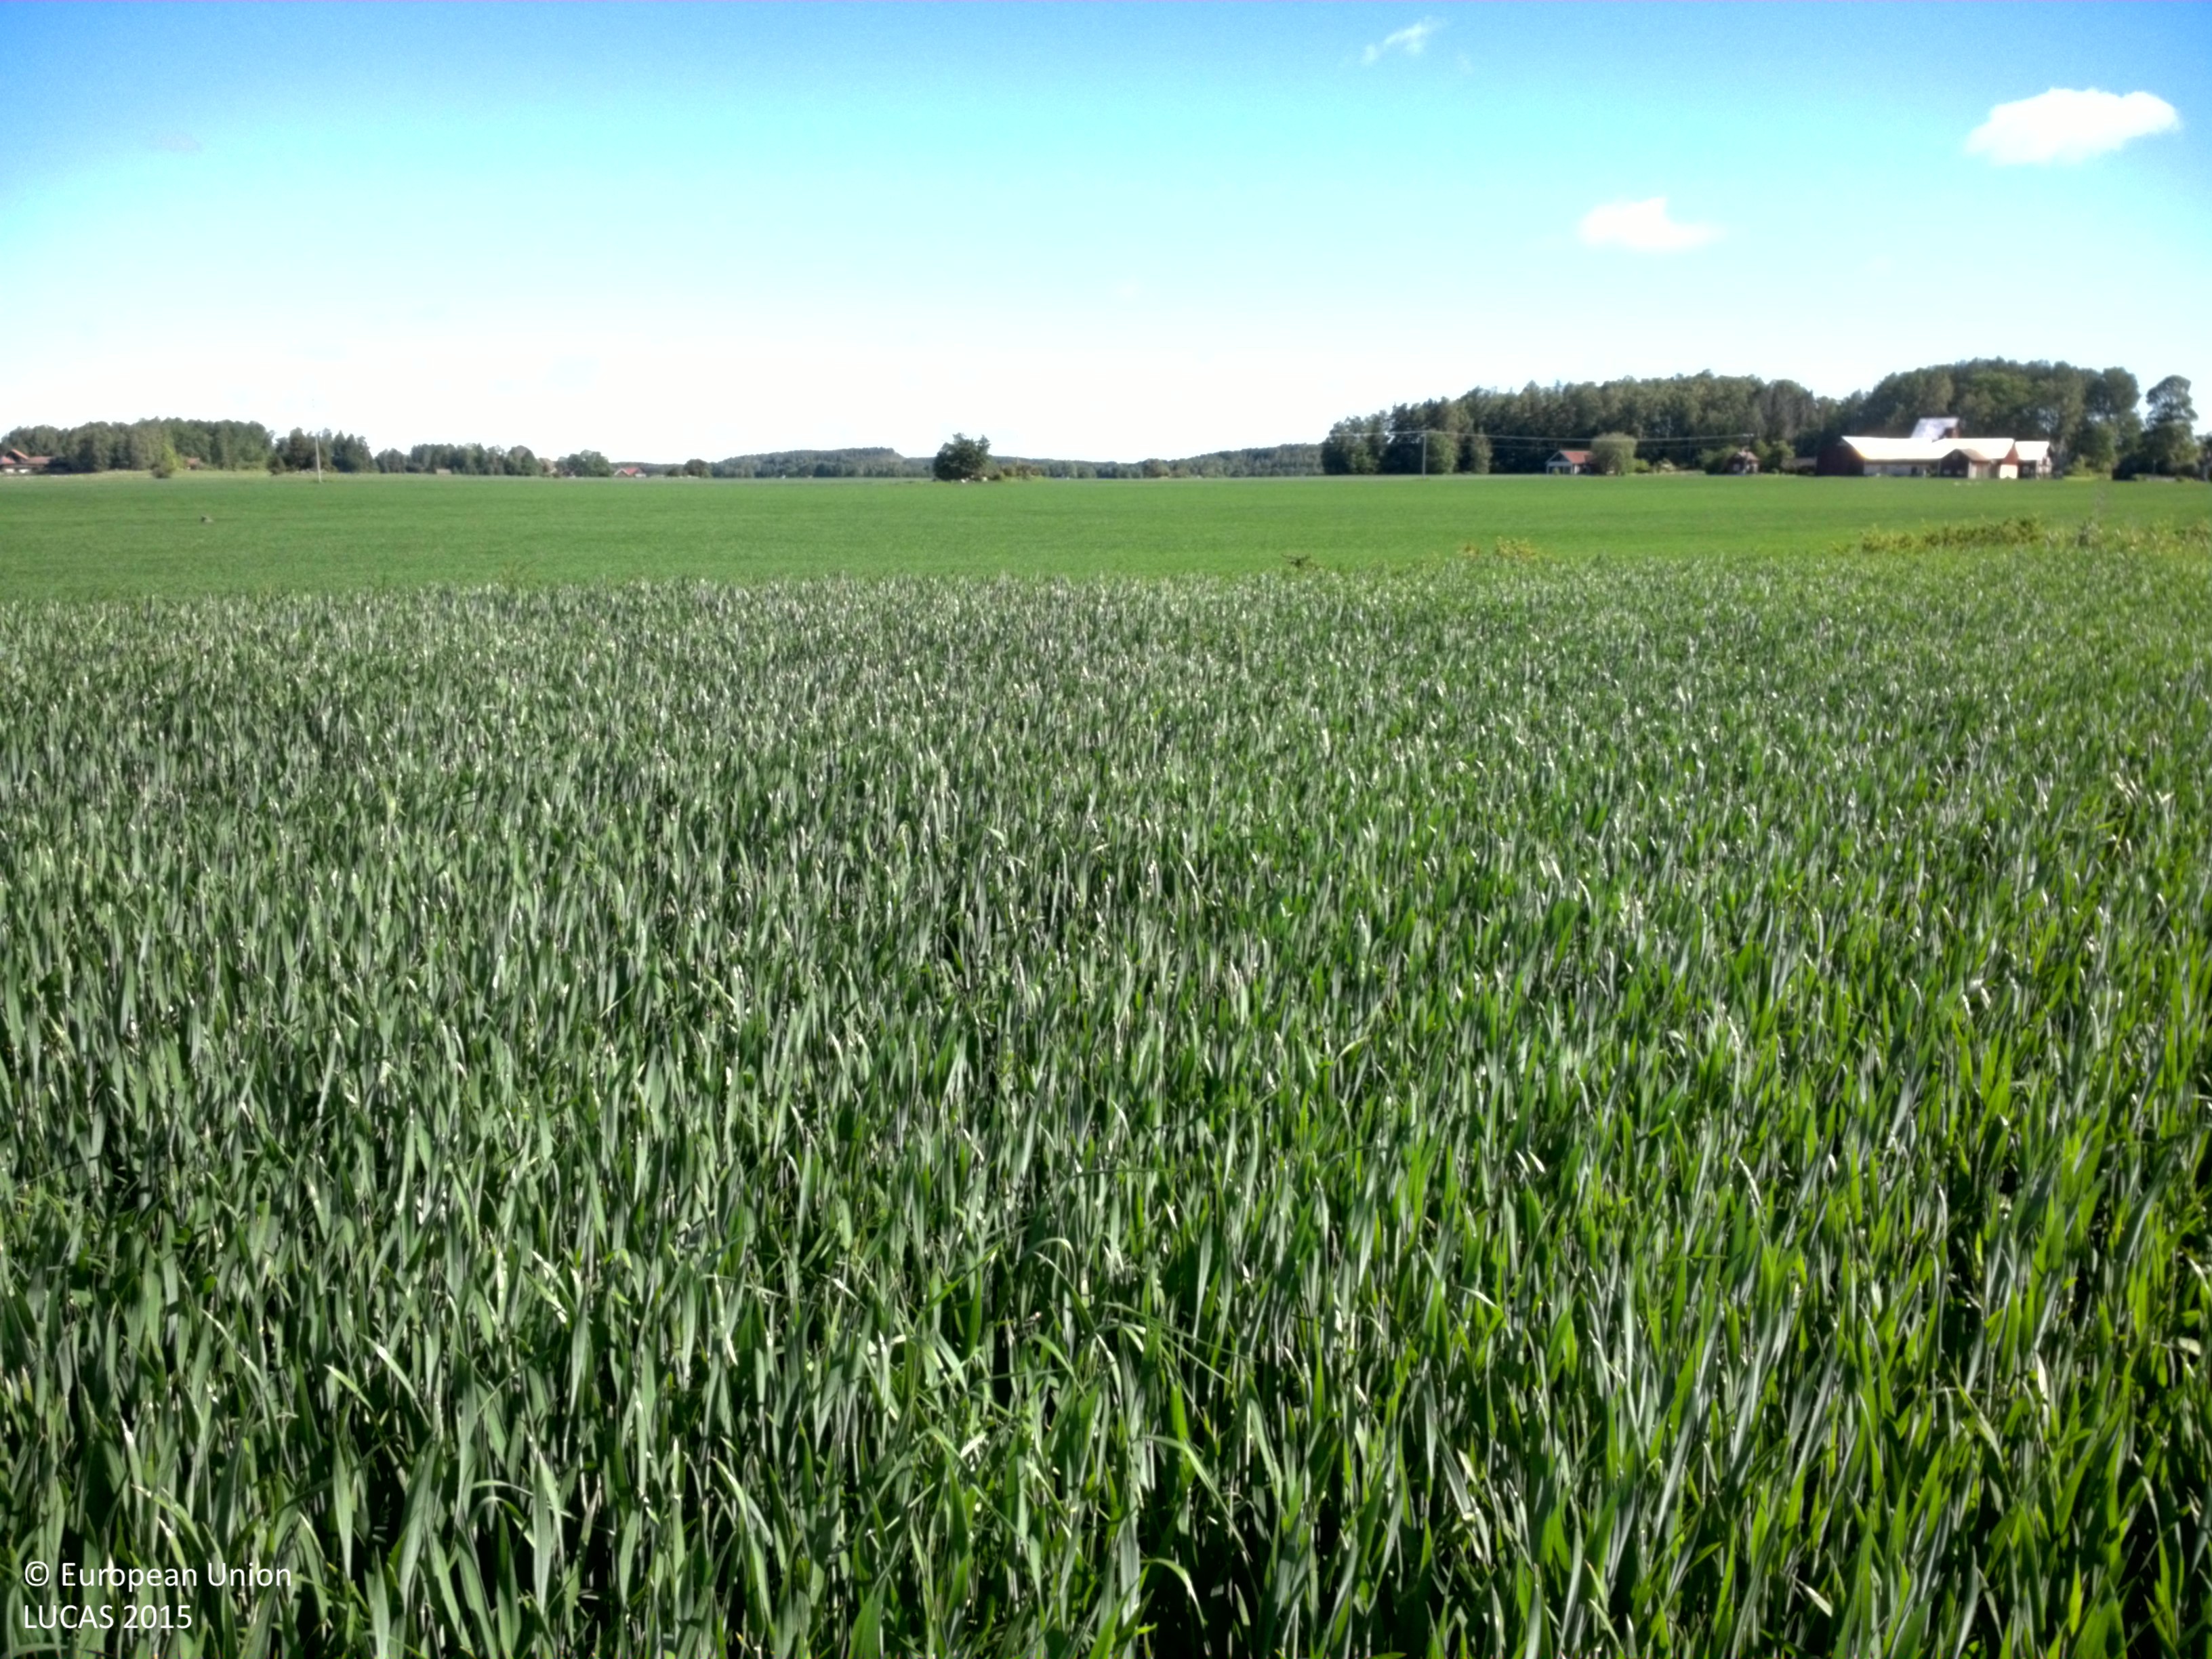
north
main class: Cropland
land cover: Common wheat
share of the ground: > 75 %
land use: Agriculture (excluding fallow land and kitchen gardens)
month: June
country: SE
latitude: 59.9592
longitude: 17.5688
